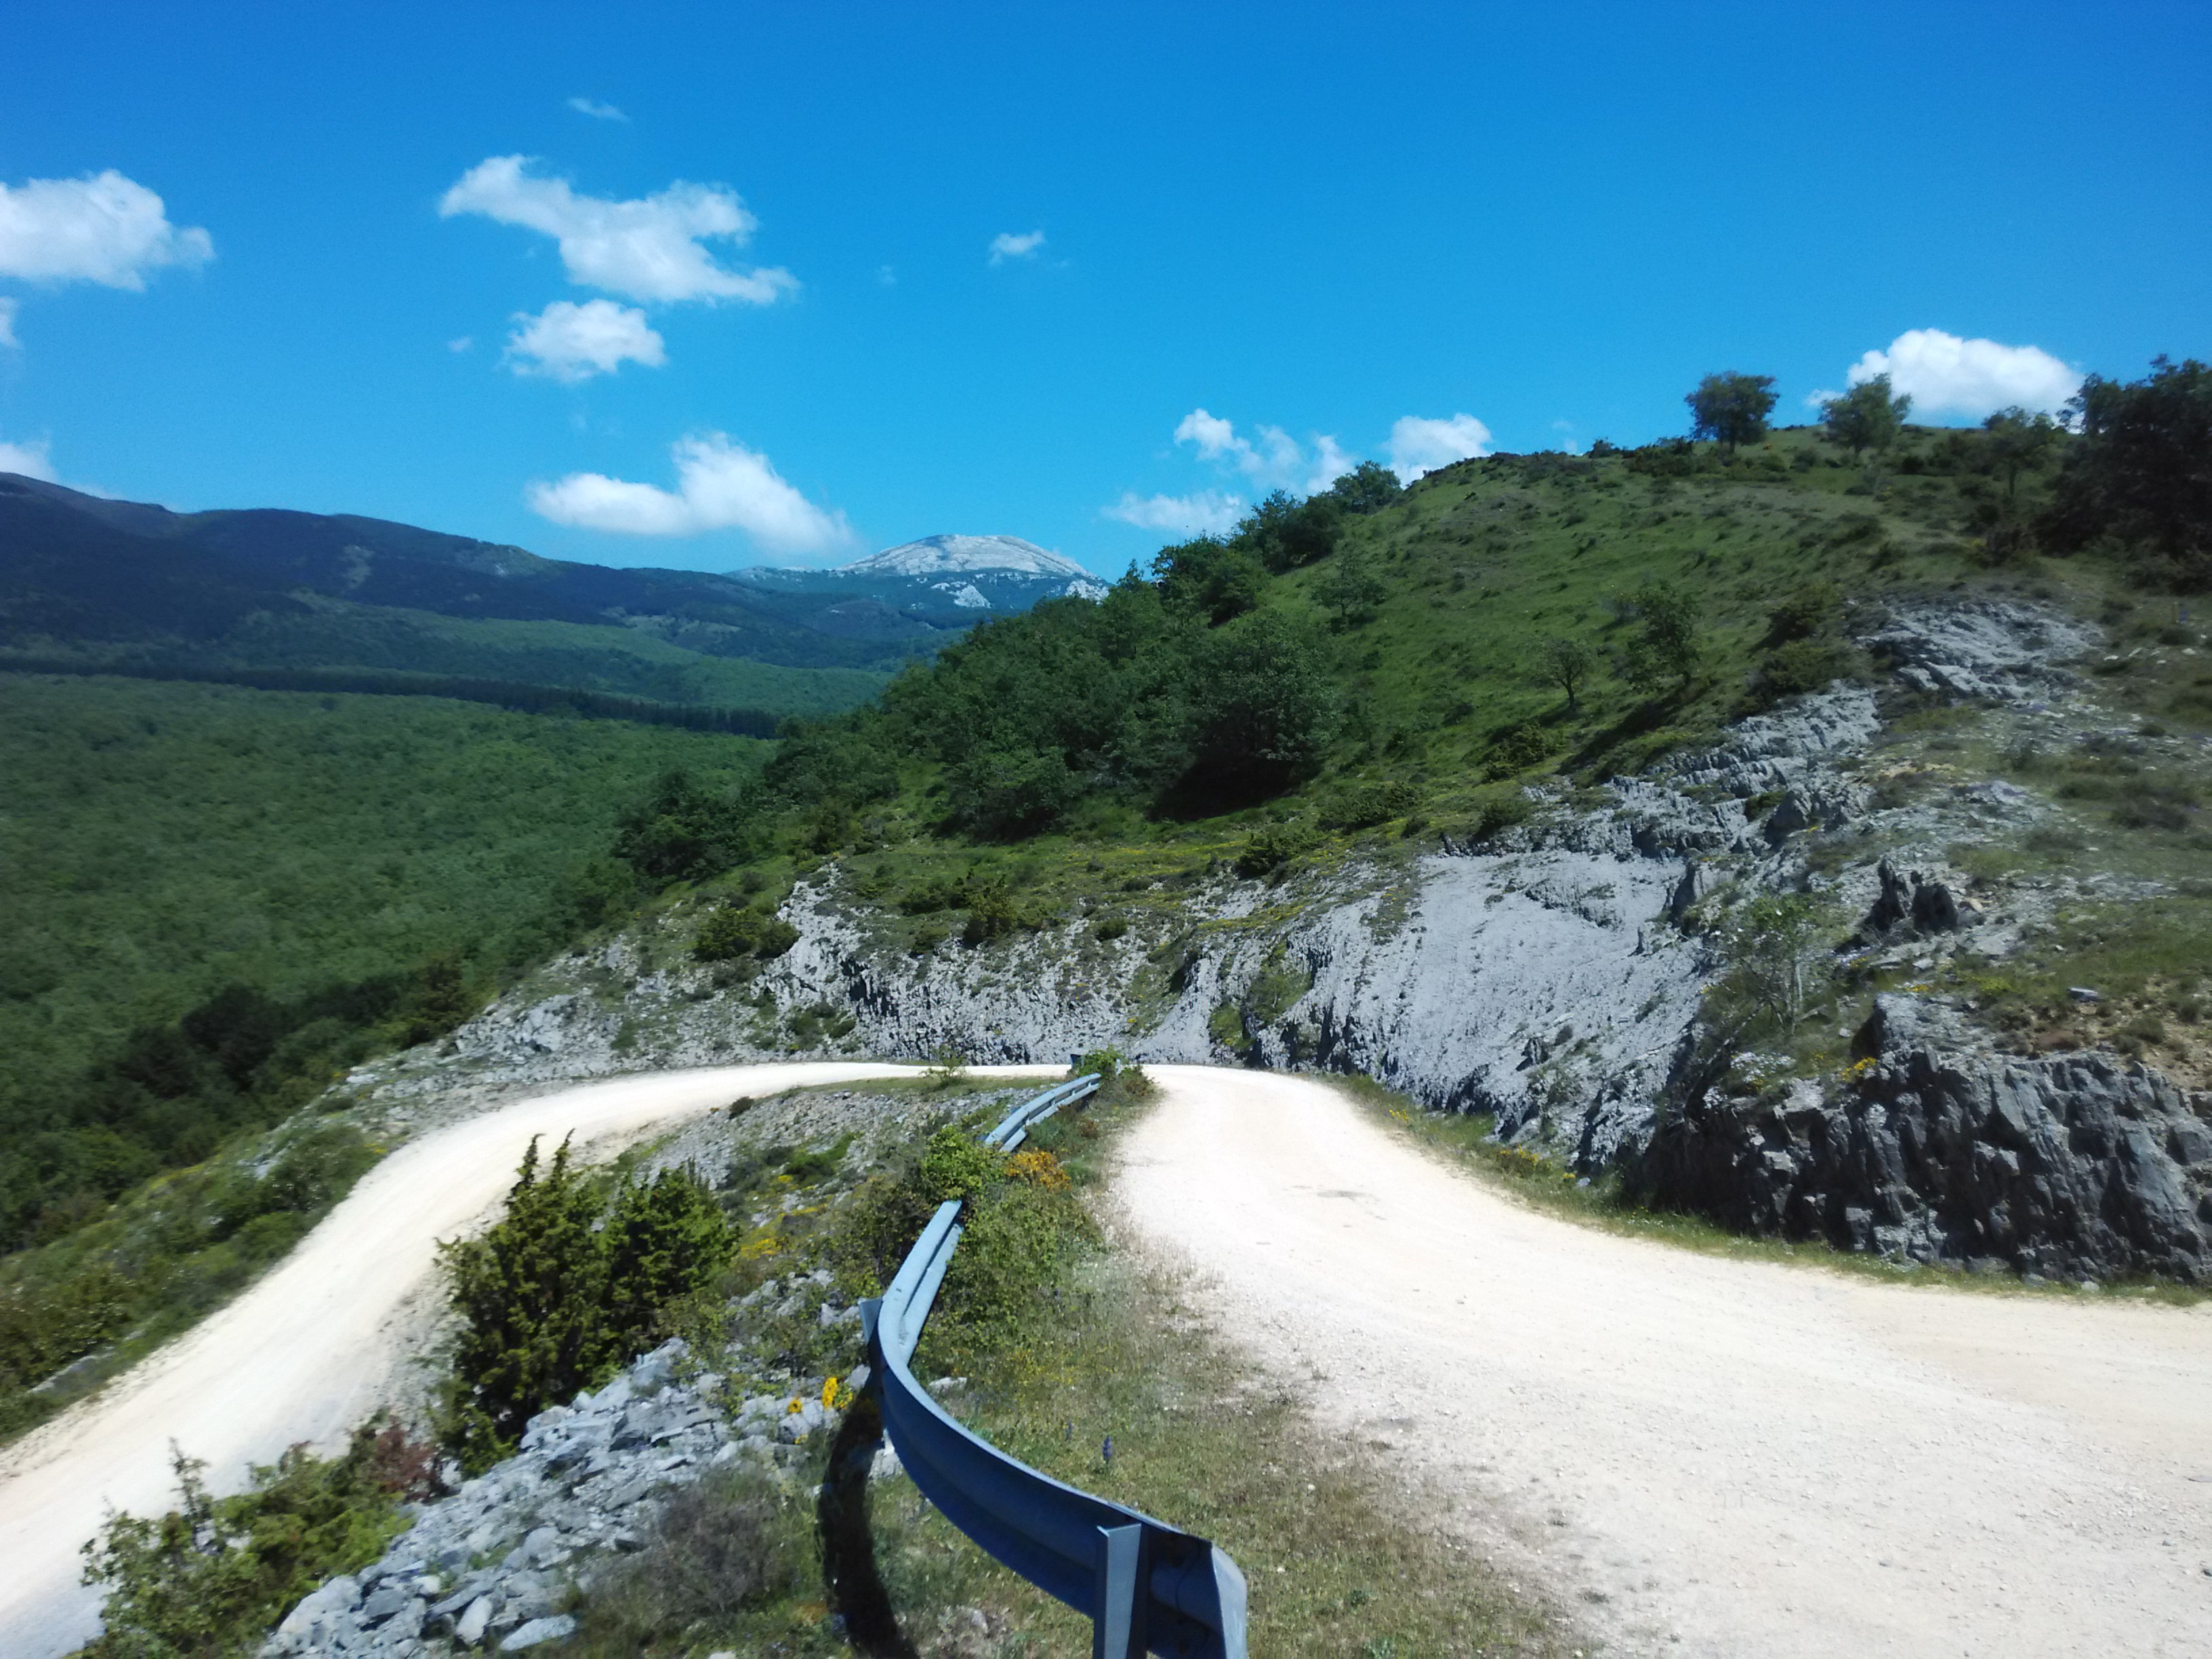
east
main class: Woodland
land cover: Broadleaved woodland
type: acidophilous oak and oak-birch forest
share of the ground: > 75 %
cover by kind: broadleaved forest trees 100 %
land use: Forestry
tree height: > 5 m
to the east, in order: Broadleaved woodland; Tracks; Broadleaved woodland
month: June
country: ES
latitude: 42.9334
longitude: -2.3630
